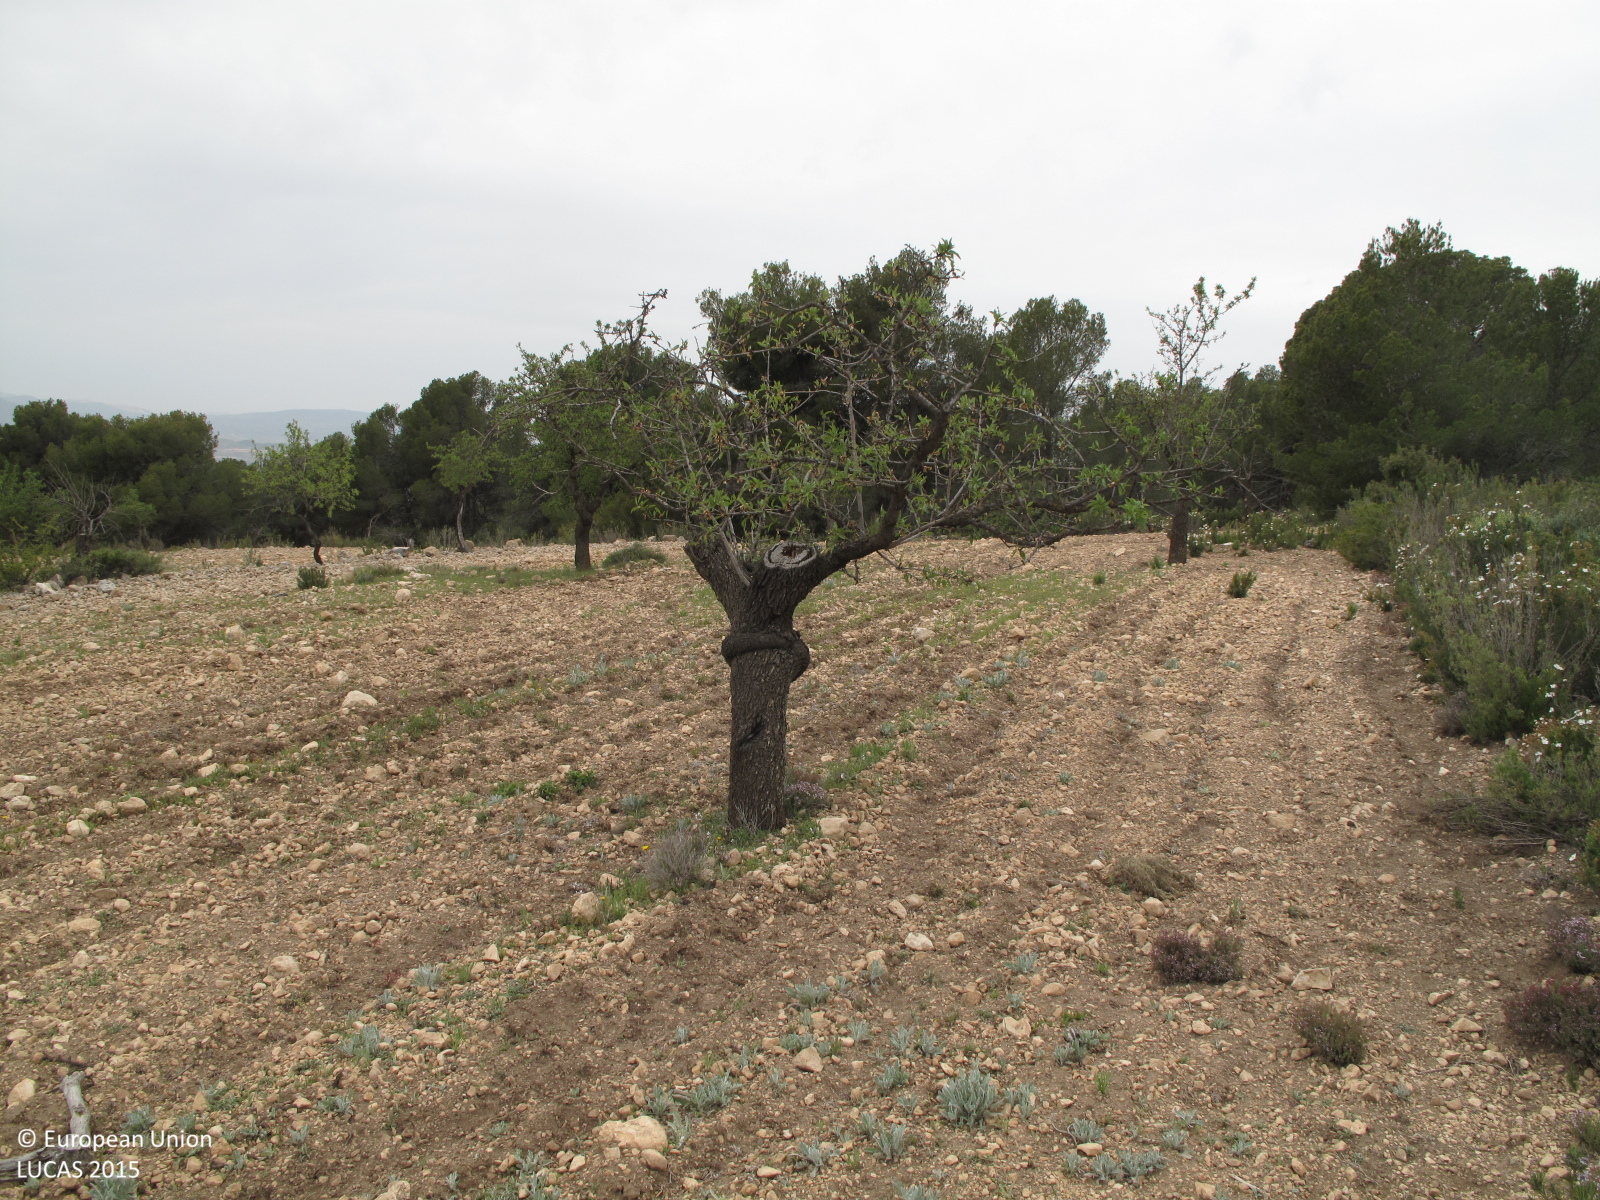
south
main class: Woodland
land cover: Pine dominated coniferous woodland
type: coniferous forest of the mediterranean region
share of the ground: 50 - 75 %
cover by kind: coniferous forest trees 40 %, shrubs 30 %, consolidated bare surface 20 %, herbaceous plants 10 %
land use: Semi-natural and natural areas not in use
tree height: > 5 m
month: April
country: ES
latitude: 38.4983
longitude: -0.9853
